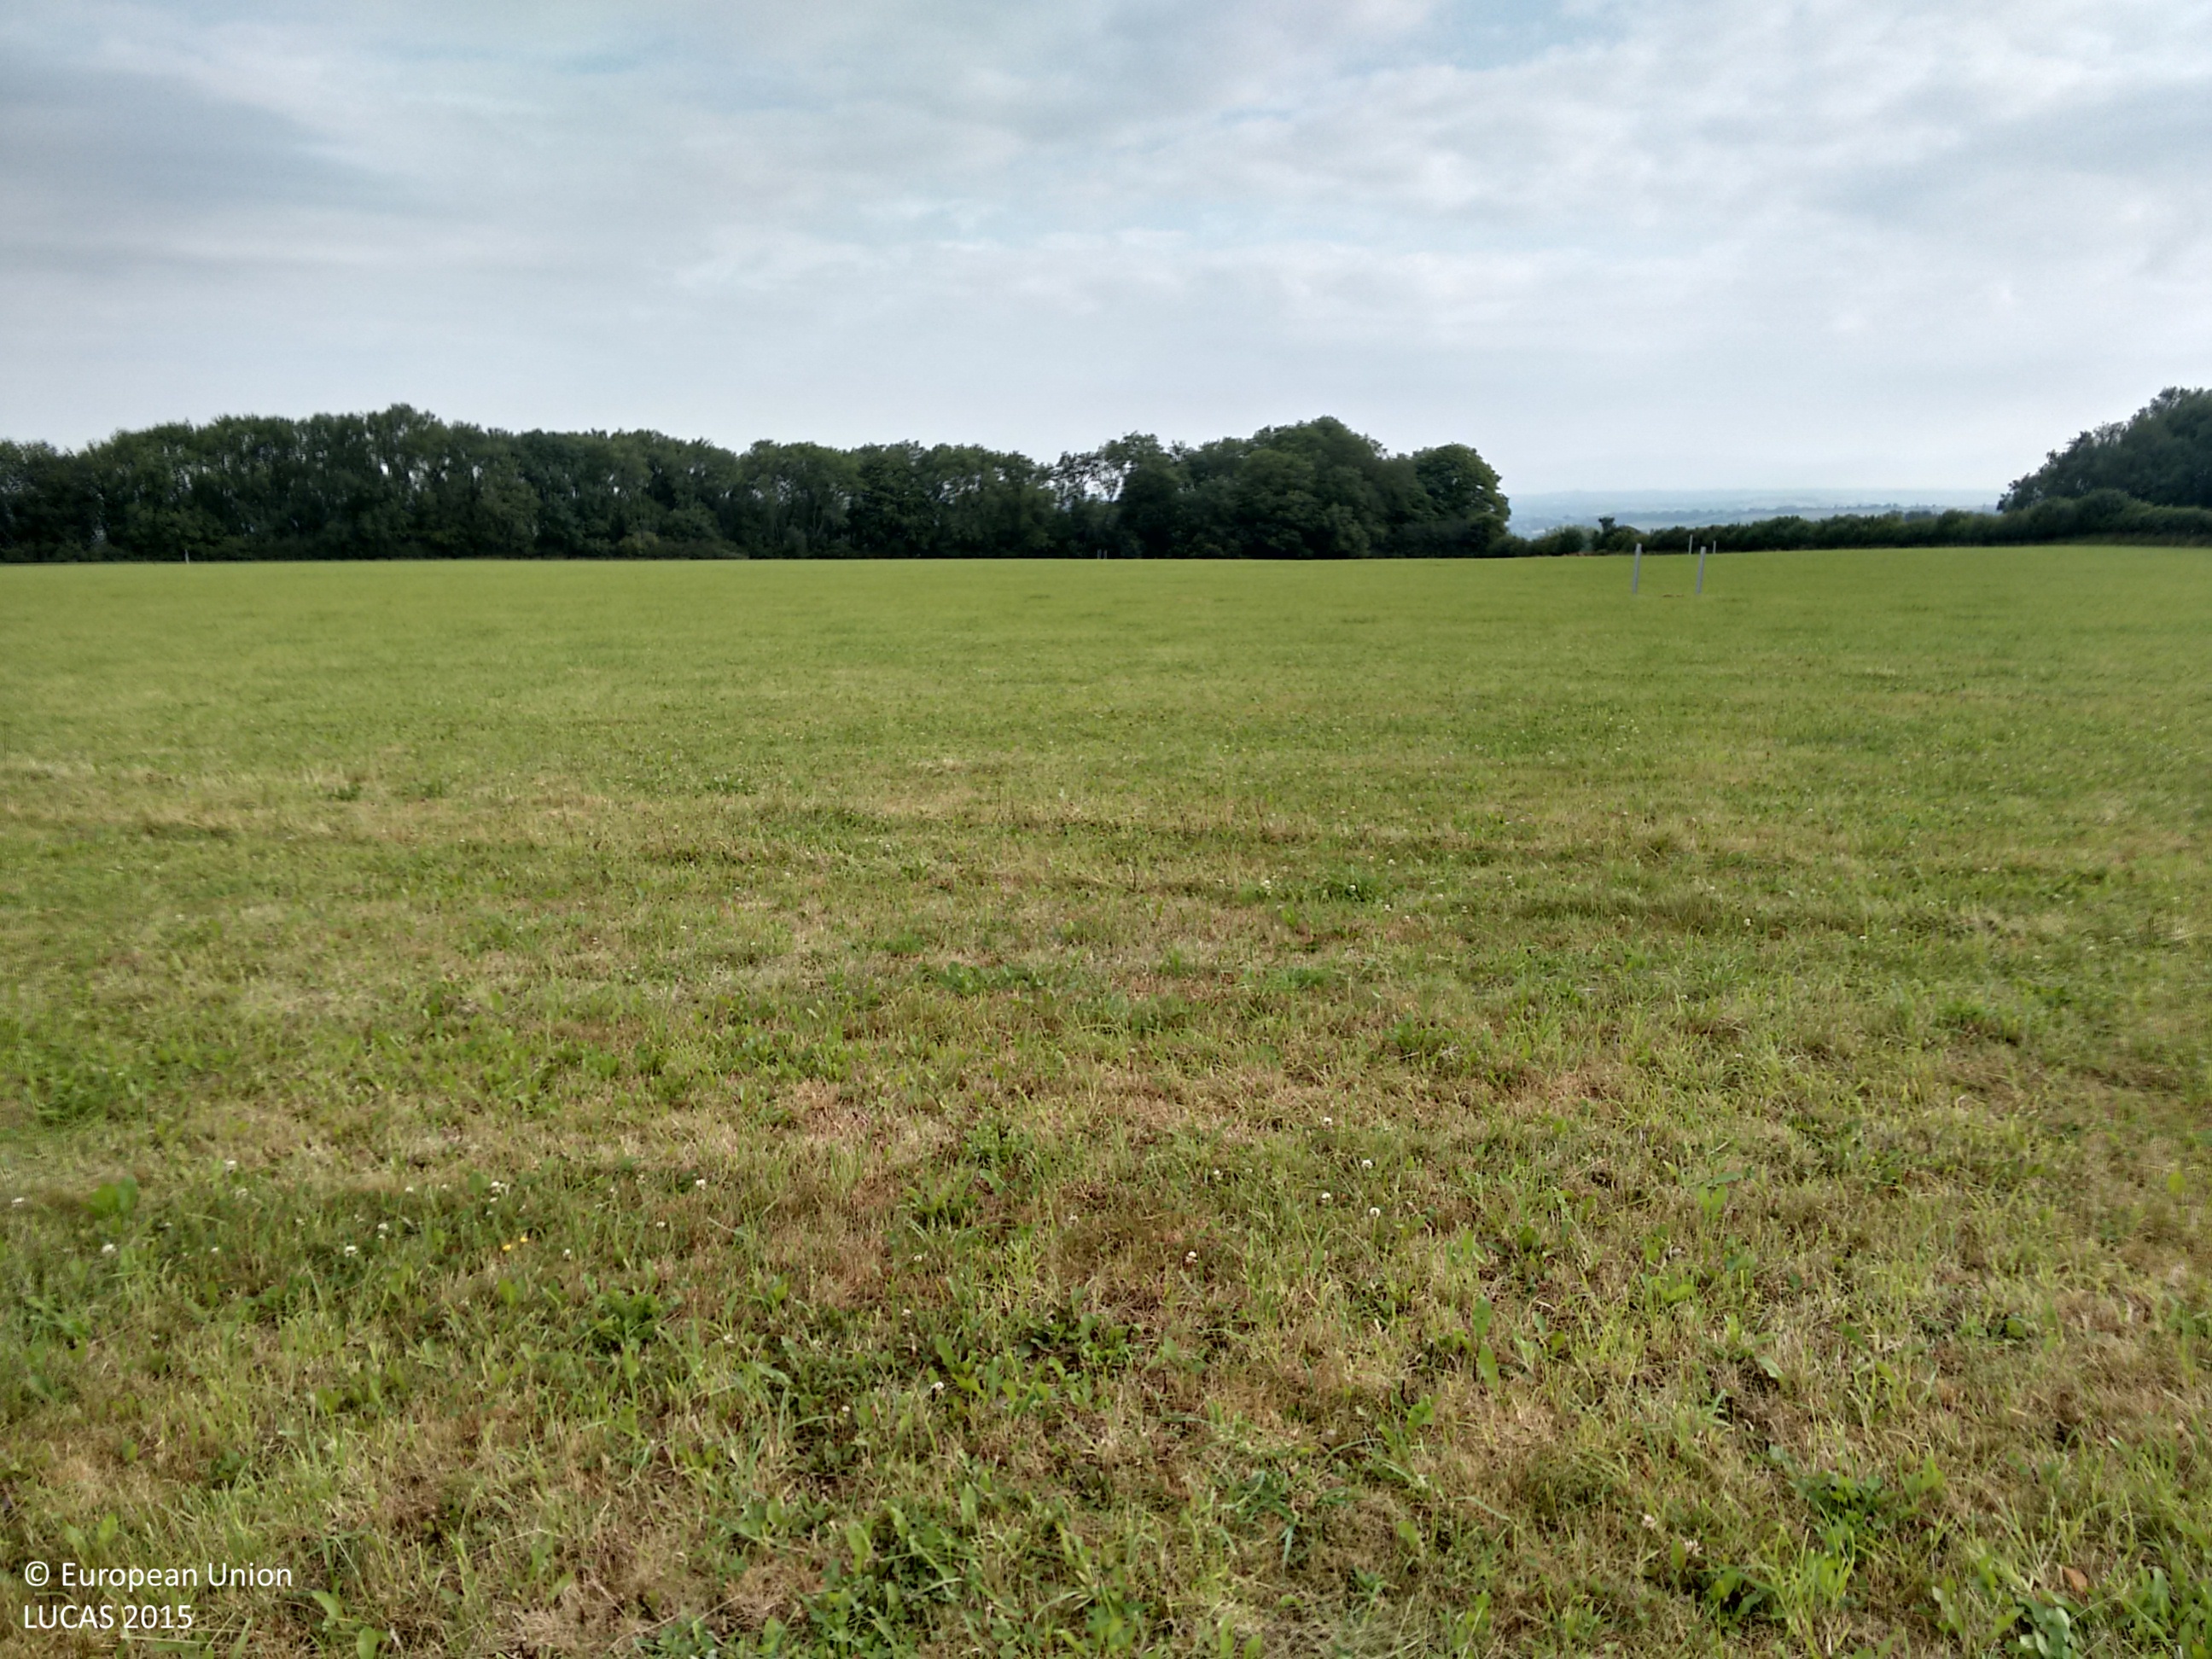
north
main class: Grassland
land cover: Grassland without tree/shrub cover
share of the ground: > 75 %
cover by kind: herbaceous plants 100 %
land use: Agriculture (excluding fallow land and kitchen gardens)
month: July
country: GB
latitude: 51.3479
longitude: -2.5147
